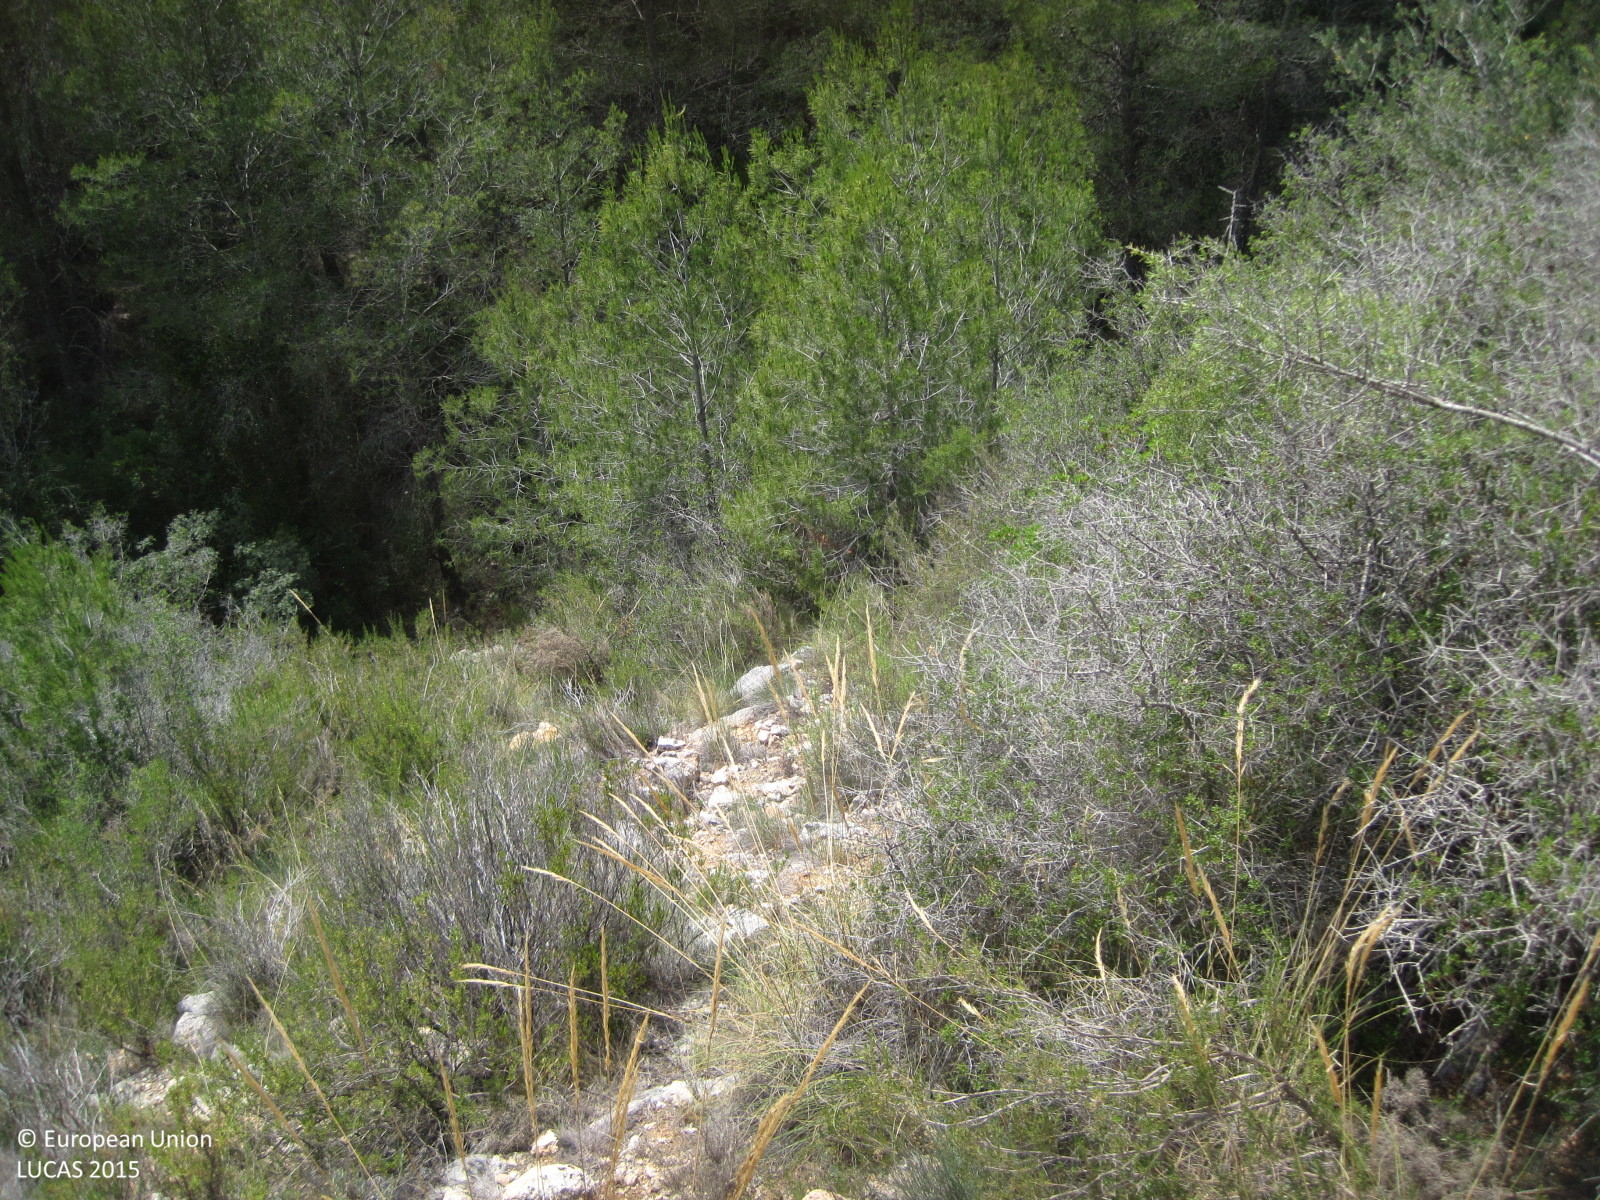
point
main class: Woodland
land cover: Pine dominated coniferous woodland
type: coniferous forest of the mediterranean region
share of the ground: 25 - 50 %
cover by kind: shrubs 40 %, coniferous forest trees 35 %, herbaceous plants 20 %, consolidated bare surface 5 %
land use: Semi-natural and natural areas not in use
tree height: > 5 m
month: June
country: ES
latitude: 39.2717
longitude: -0.6021
